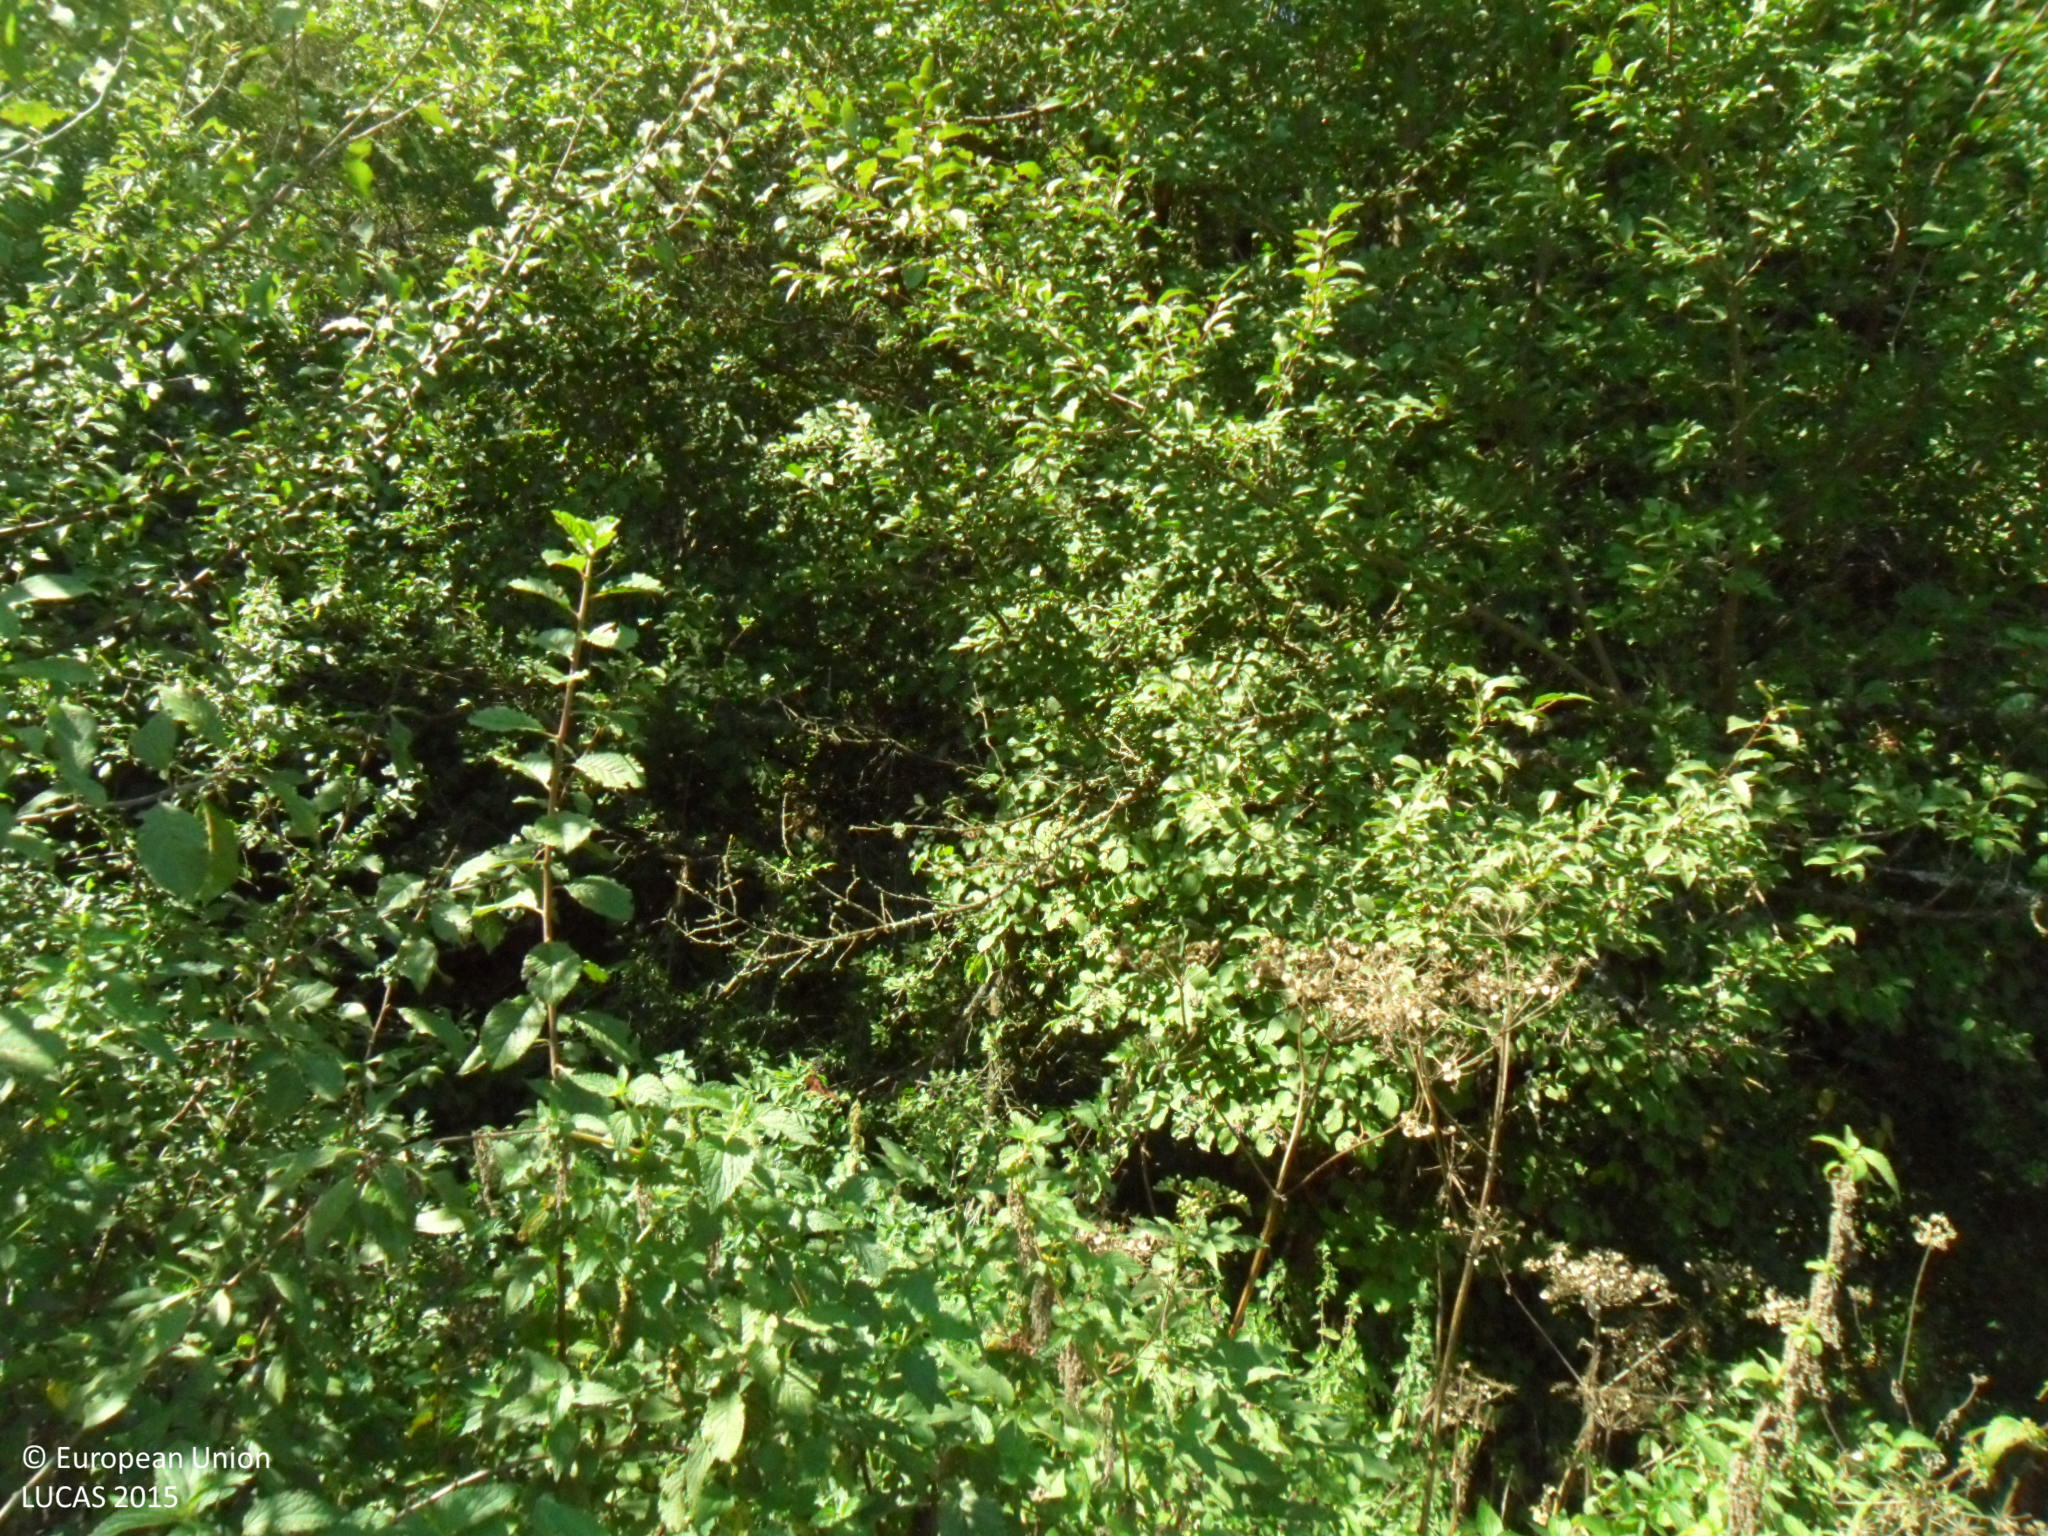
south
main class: Shrubland
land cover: Shrubland with sparse tree cover
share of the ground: > 75 %
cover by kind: shrubs 95 %, broadleaved forest trees 5 %
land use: Forestry
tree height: > 5 m
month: September
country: BG
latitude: 43.6644
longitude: 27.1502
